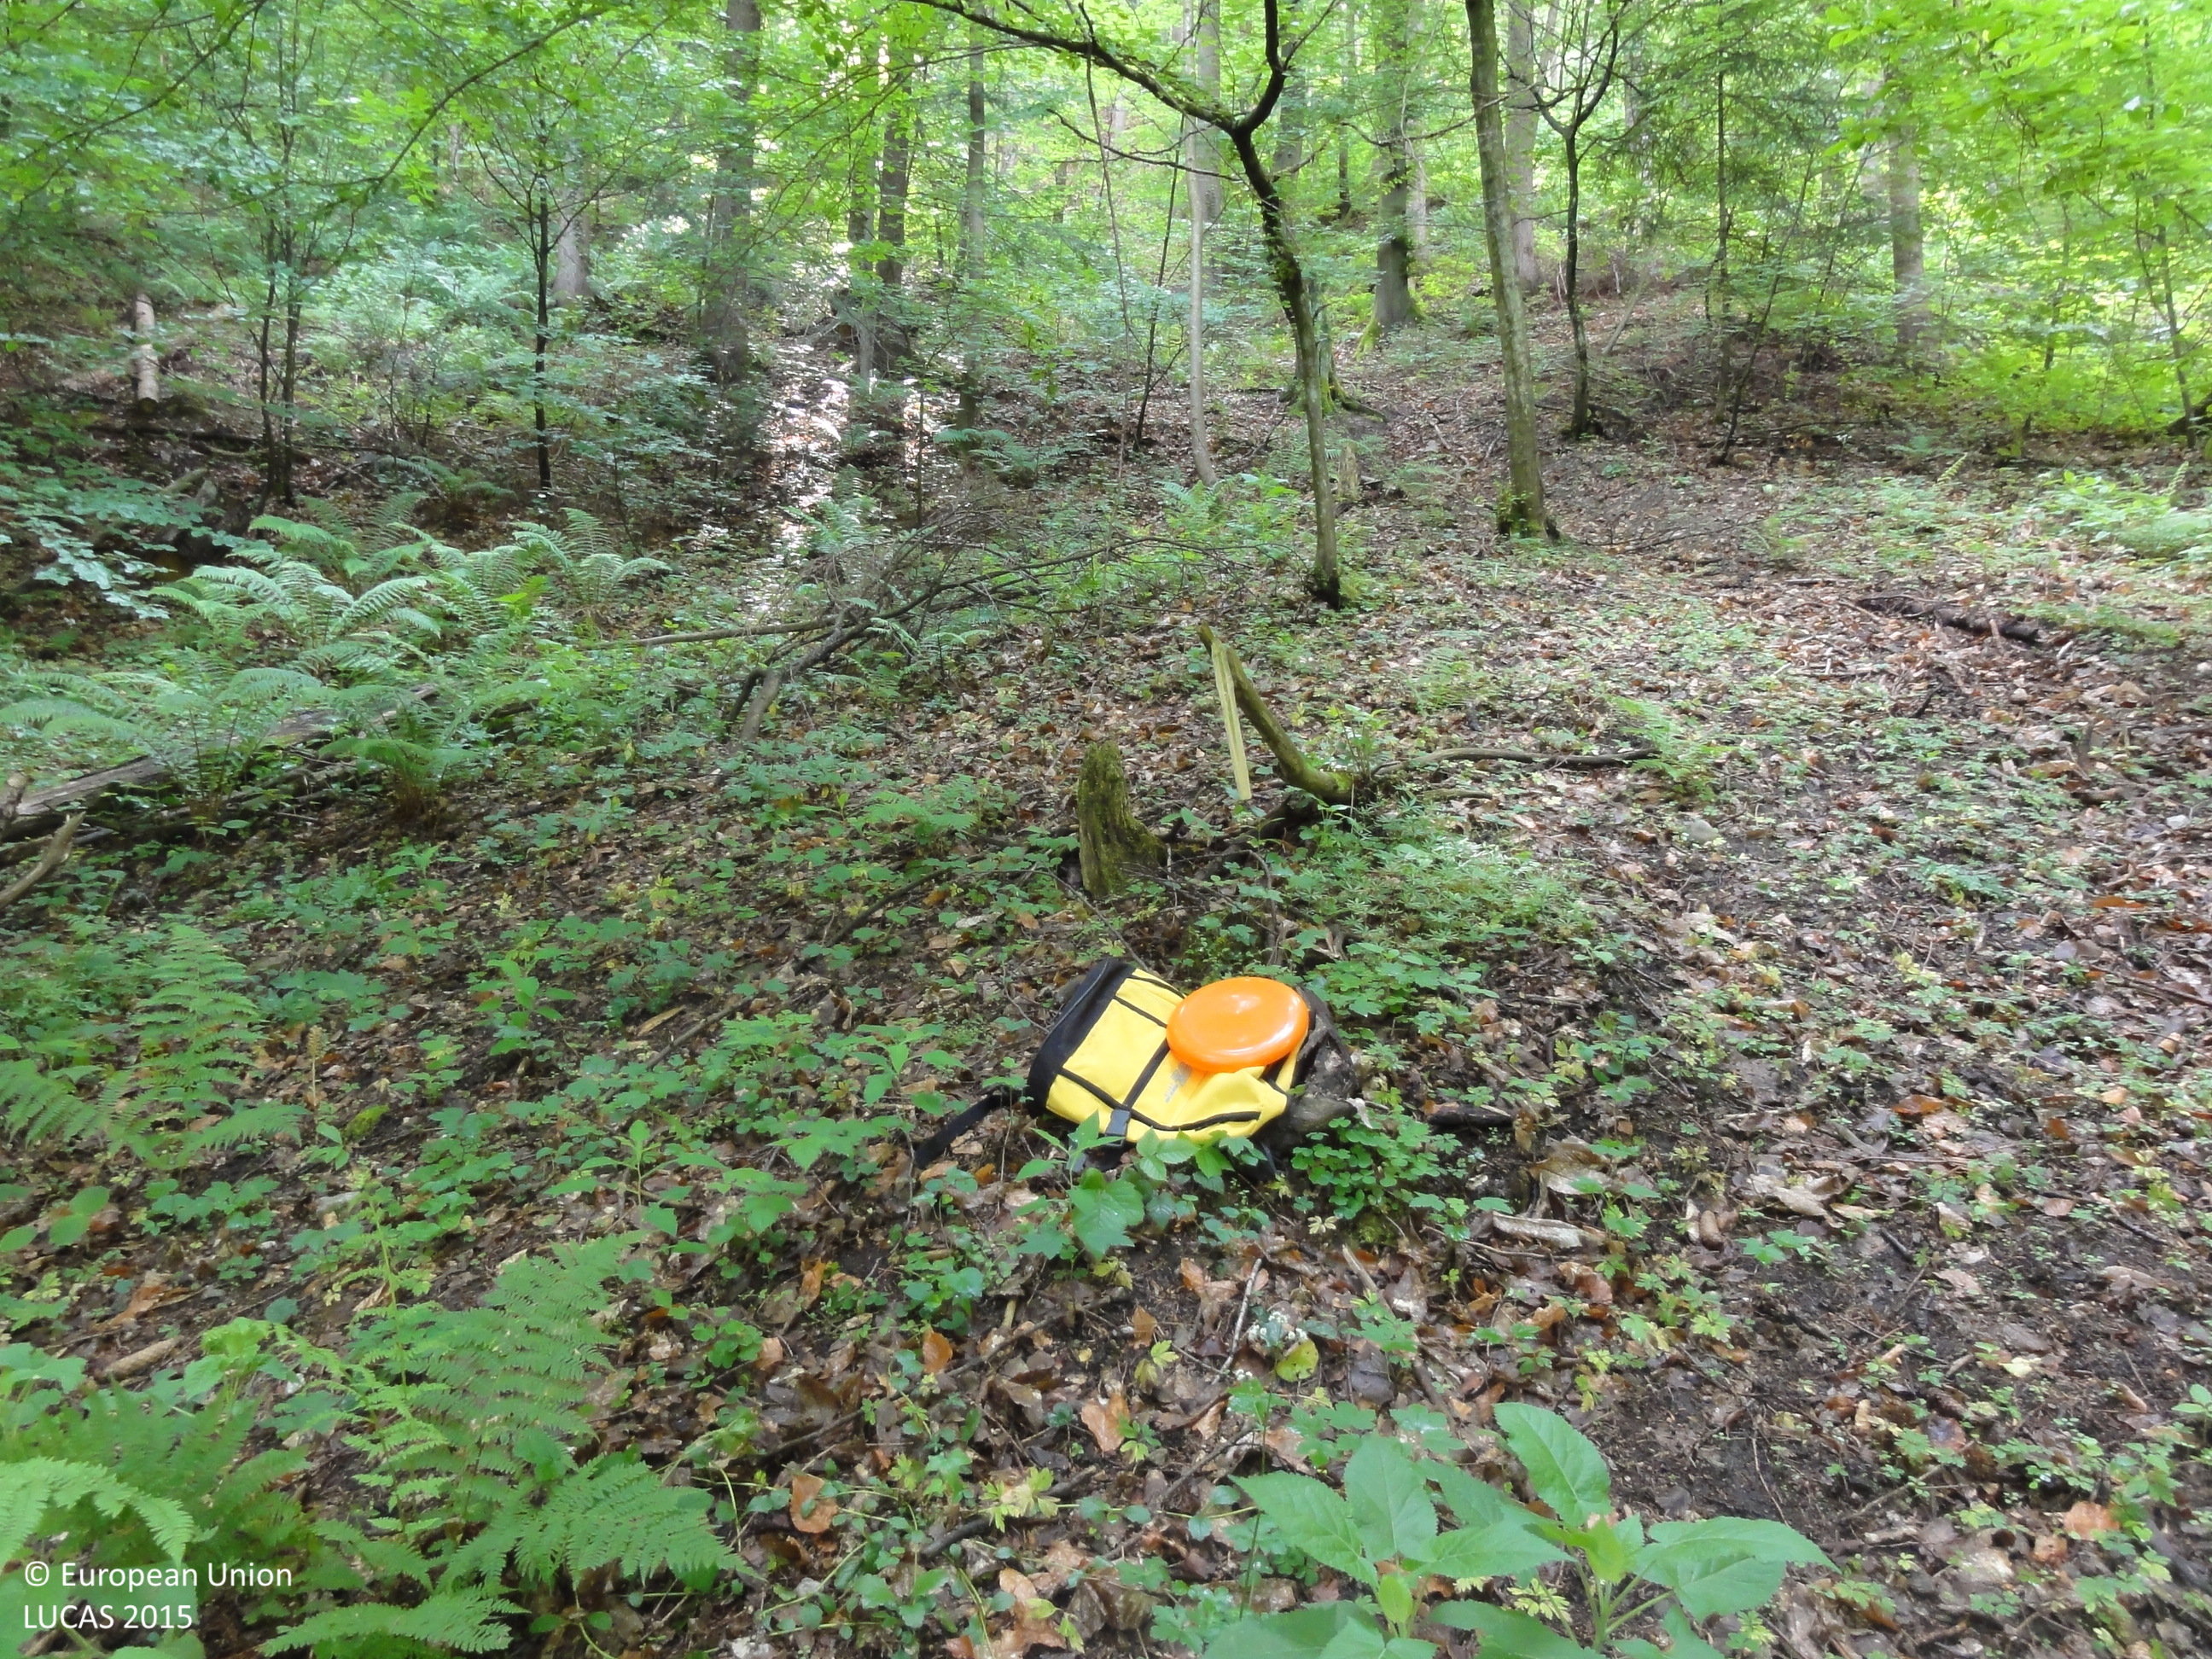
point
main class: Woodland
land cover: Spruce dominated mixed woodland
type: beech forest
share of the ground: > 75 %
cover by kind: coniferous forest trees 60 %, broadleaved forest trees 40 %
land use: Forestry
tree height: > 5 m
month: May
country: SI
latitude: 46.5505
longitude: 15.5419
